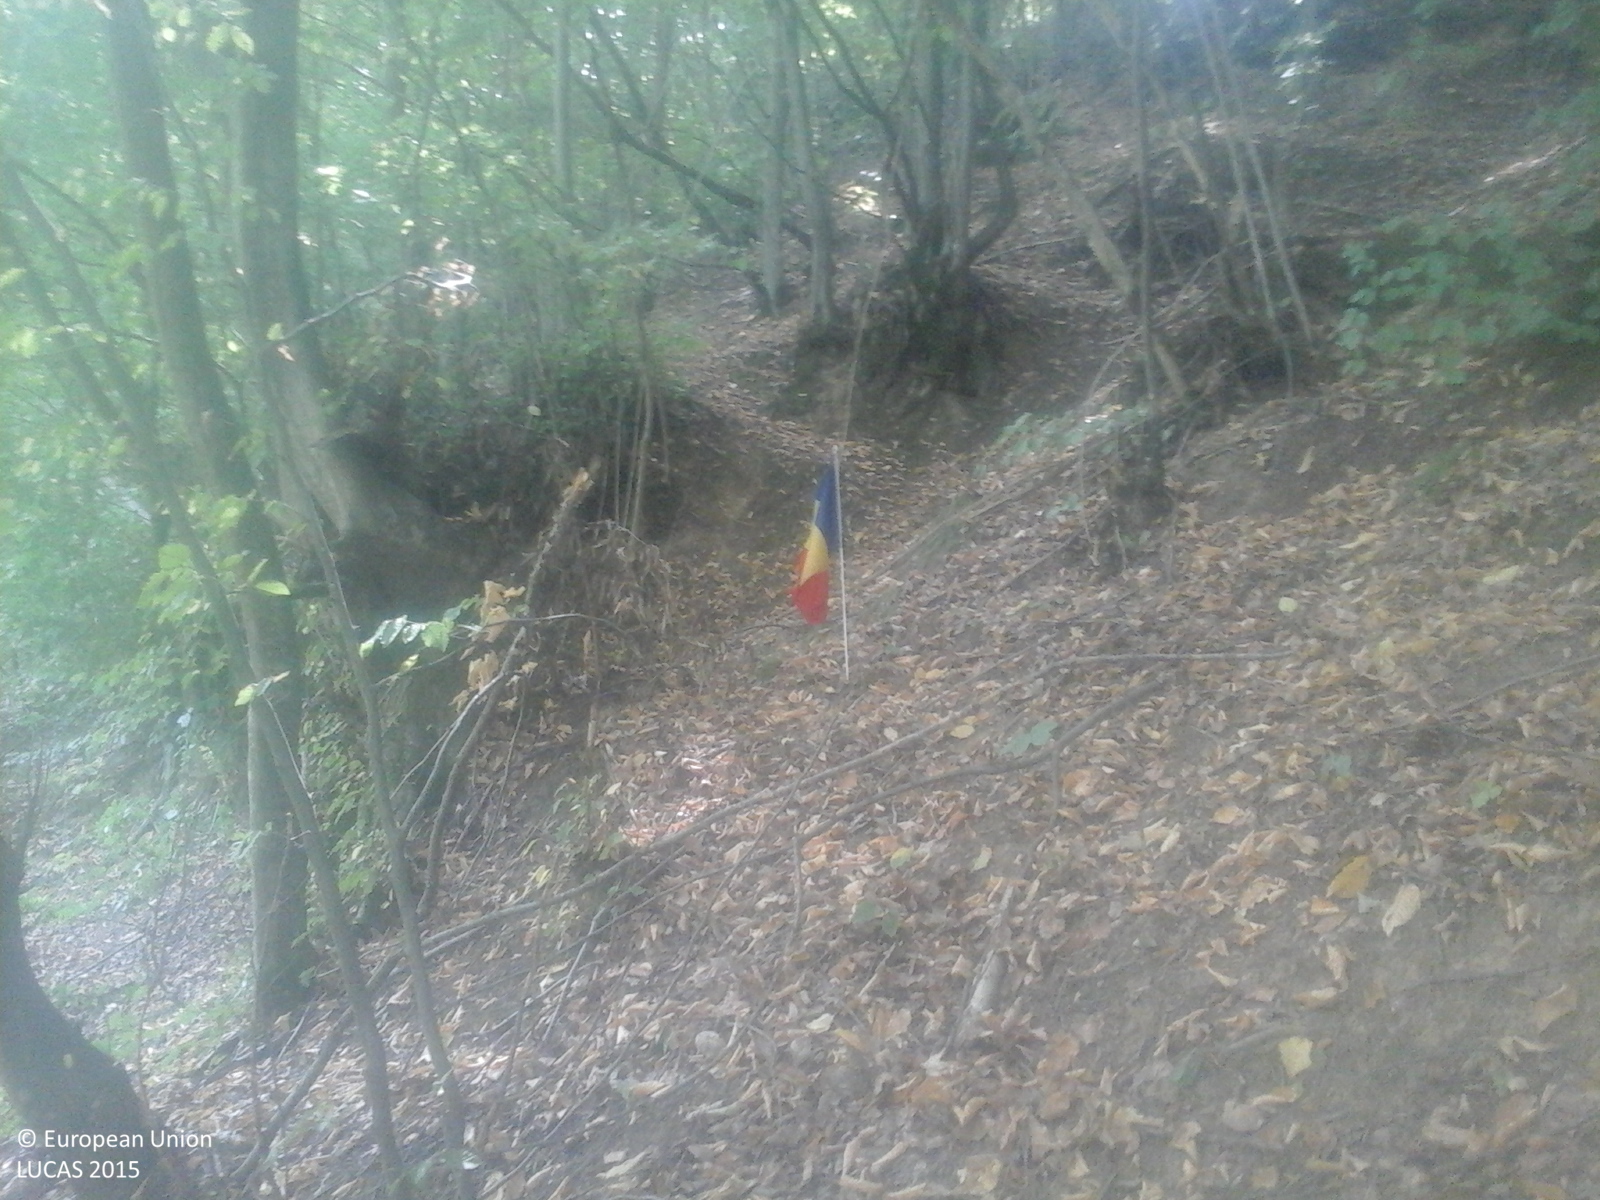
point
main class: Woodland
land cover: Broadleaved woodland
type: beech forest
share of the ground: > 75 %
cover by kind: broadleaved forest trees 100 %
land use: Forestry
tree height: > 5 m
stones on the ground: < 10 %
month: September
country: RO
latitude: 47.7112
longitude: 24.3941
